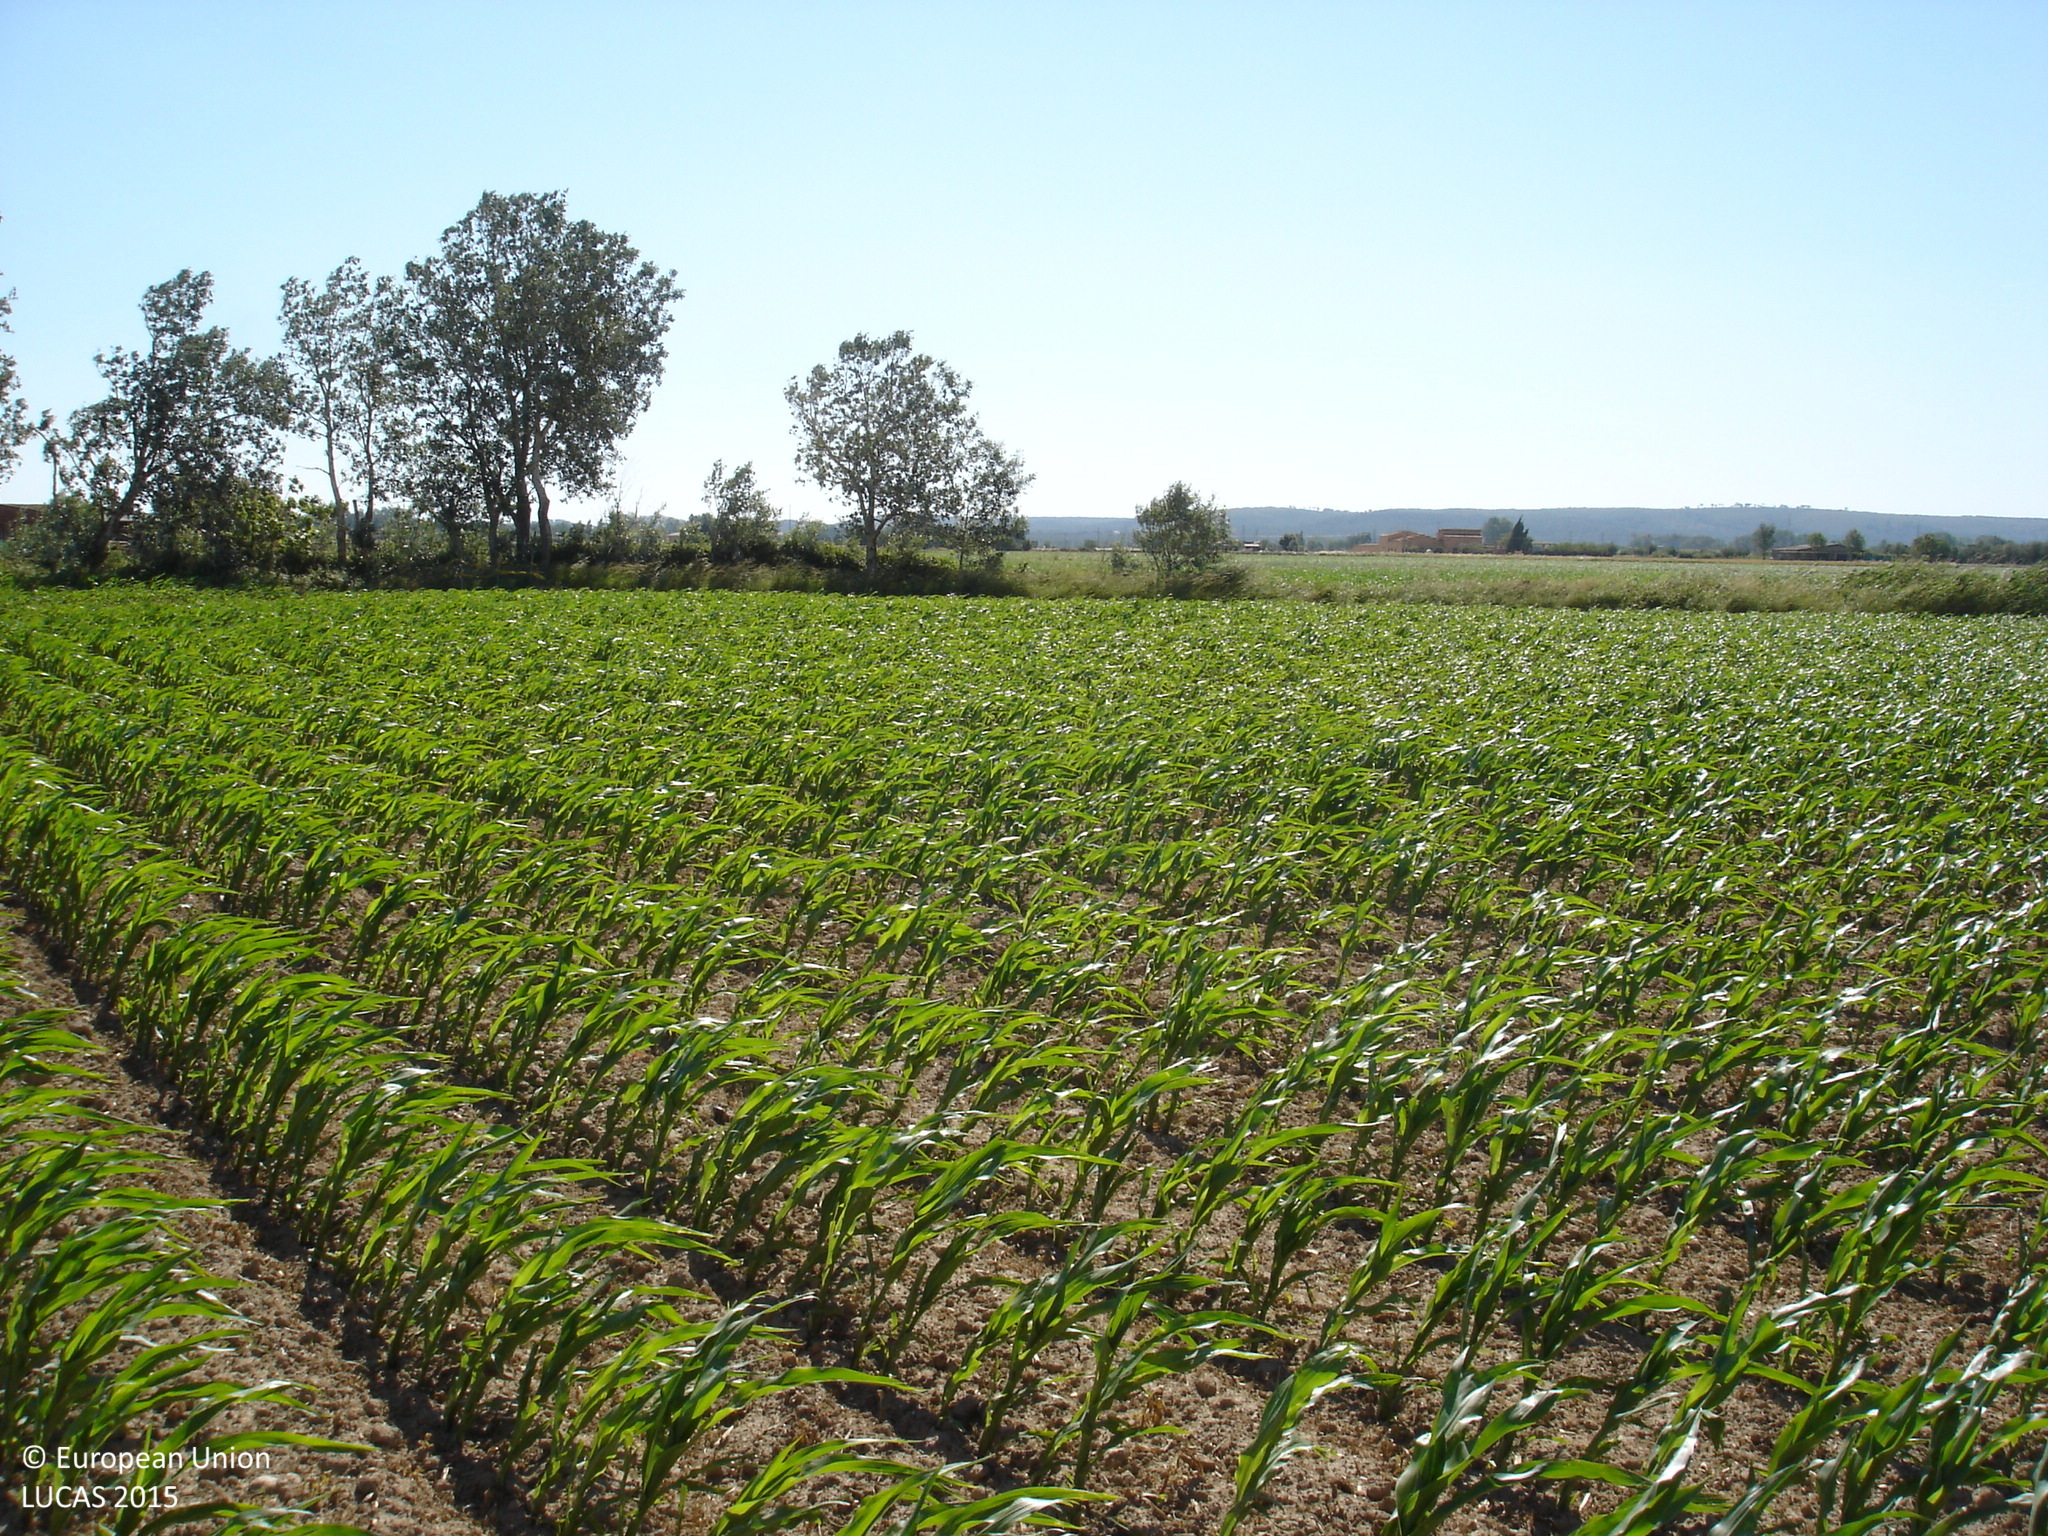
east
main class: Cropland
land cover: Maize
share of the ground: 25 - 50 %
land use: Agriculture (excluding fallow land and kitchen gardens)
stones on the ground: < 10 %
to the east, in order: Maize; Grass margins; Tracks; Grass margins; Ditches and canals; Single bushes/trees; Maize; Fences; Grassland without tree/shrub cover; Fences; Grass margins; Tracks; Grass margins; Artificial constructions; Grass margins; Maize
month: May
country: ES
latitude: 42.1095
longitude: 3.0856
